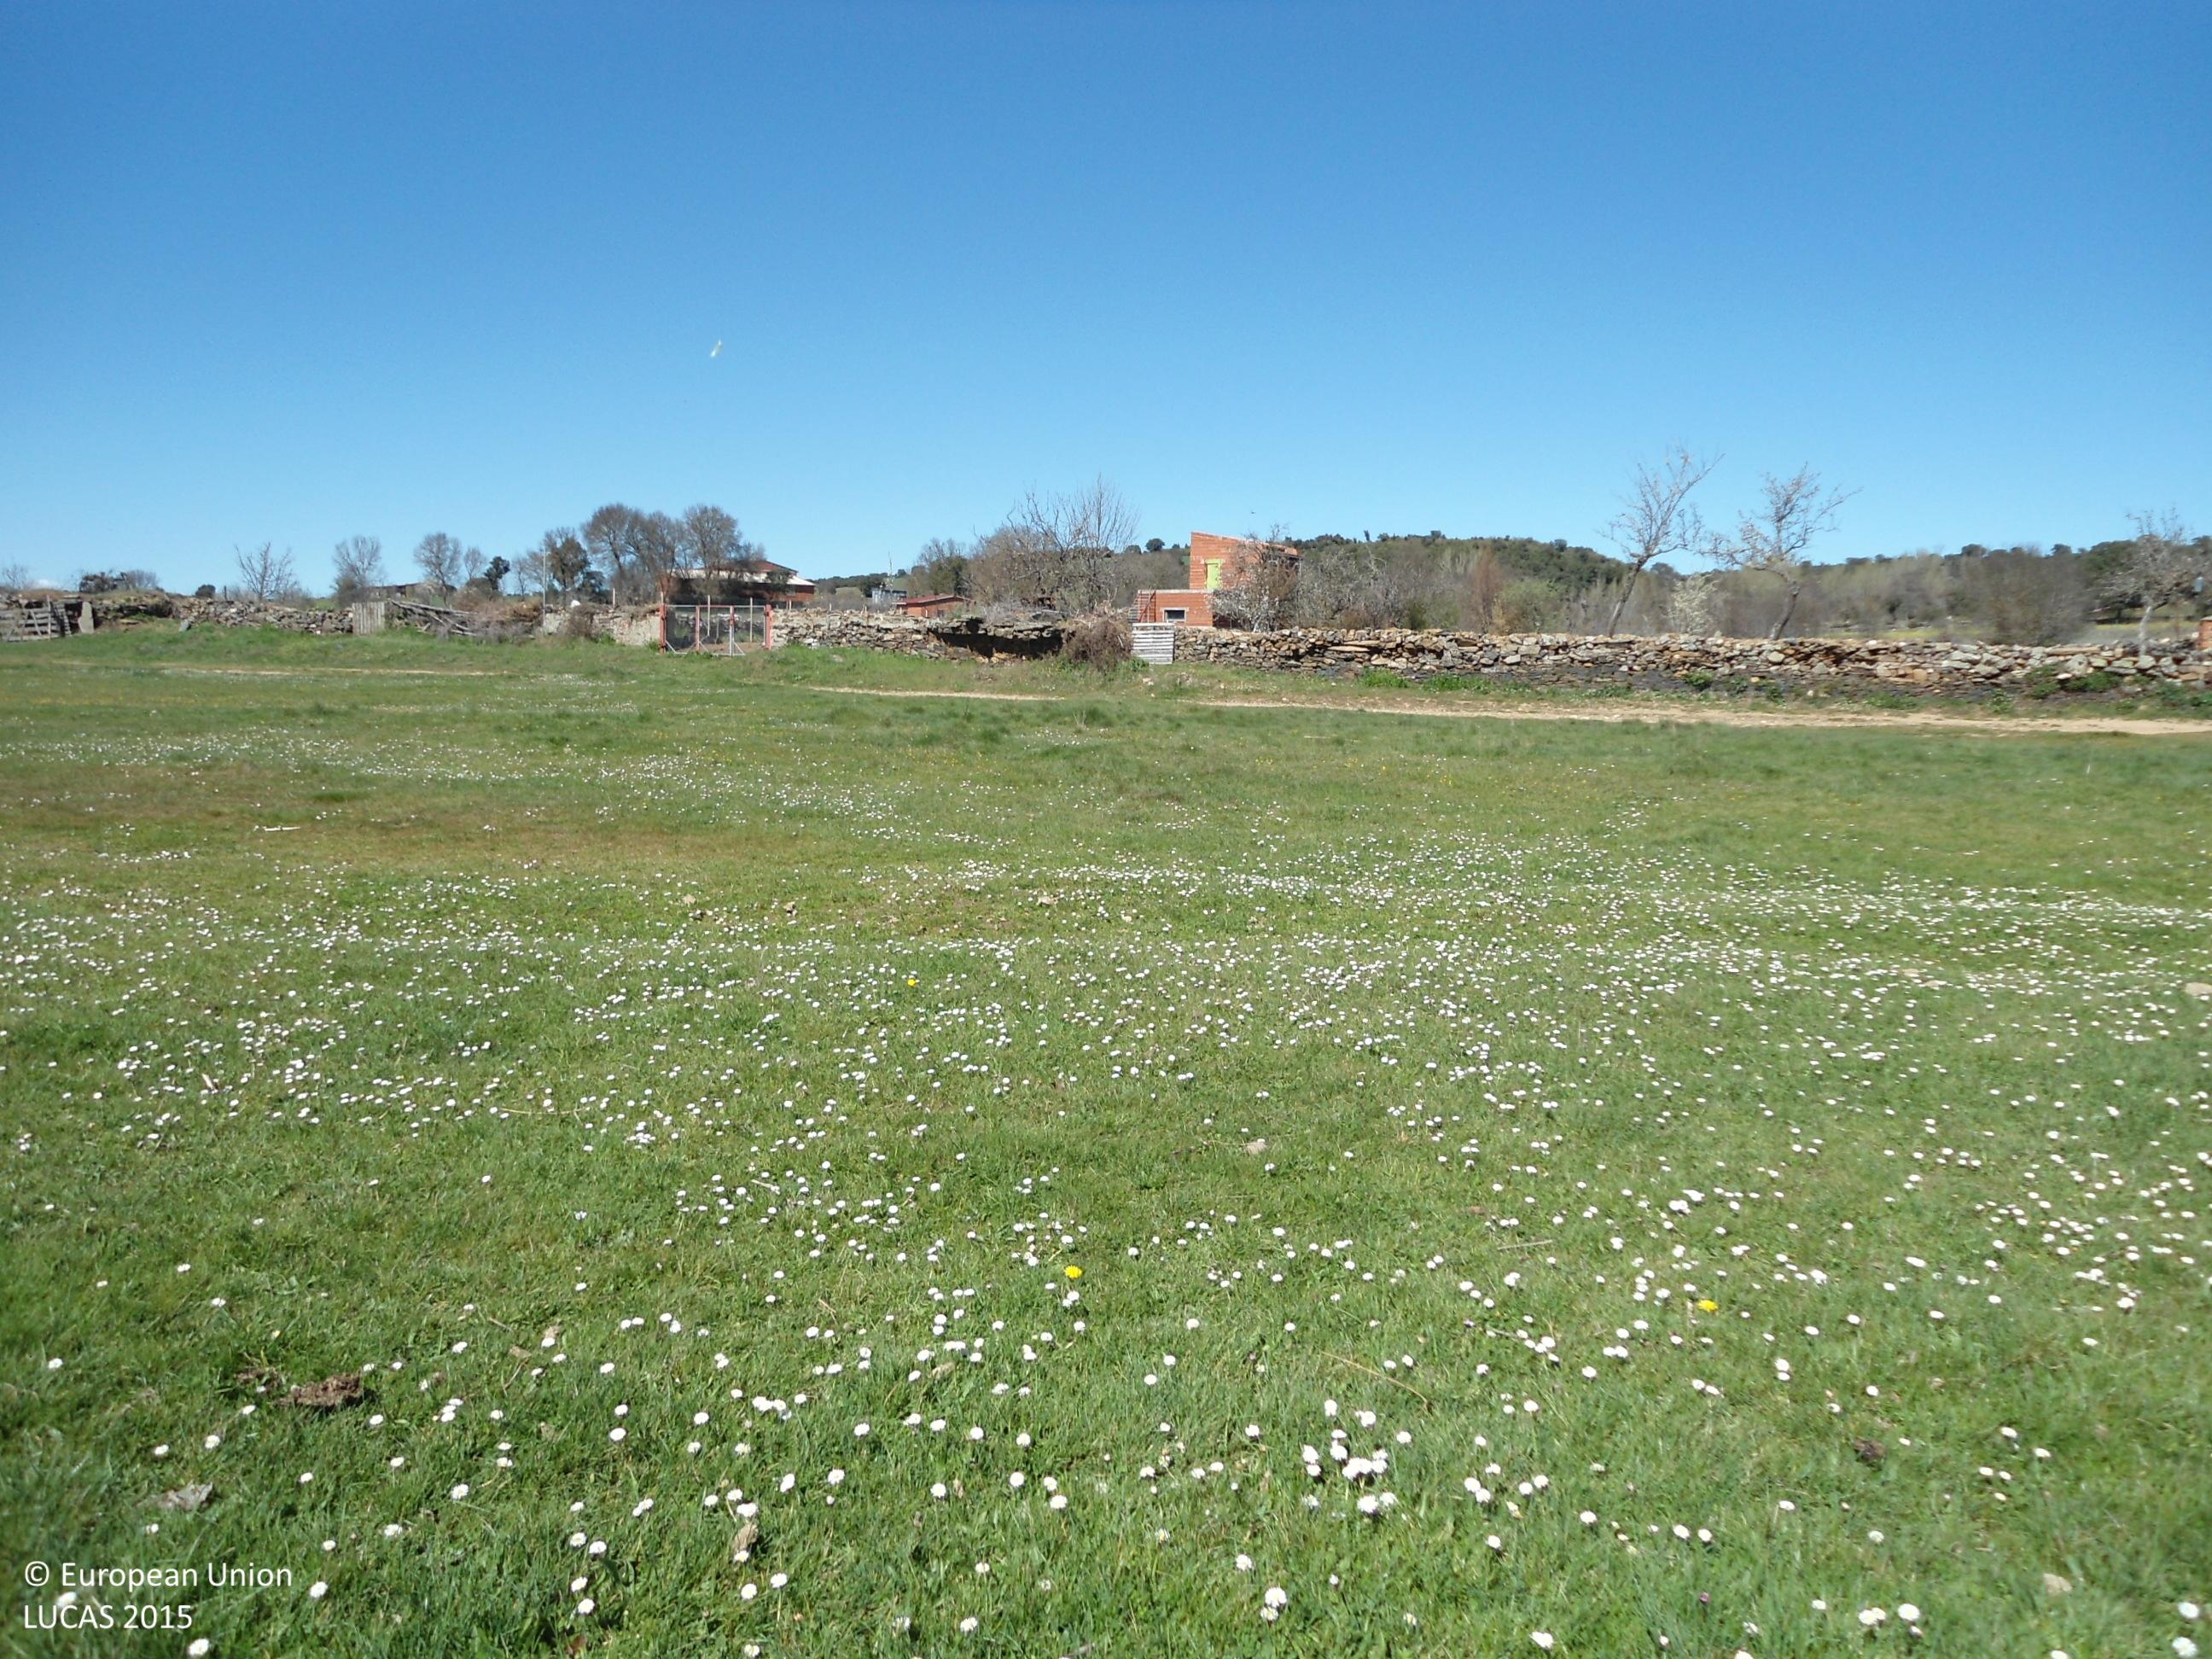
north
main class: Grassland
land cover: Grassland without tree/shrub cover
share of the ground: > 75 %
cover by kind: herbaceous plants 100 %
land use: Agriculture (excluding fallow land and kitchen gardens)
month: April
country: ES
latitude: 41.7166
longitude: -6.1440
